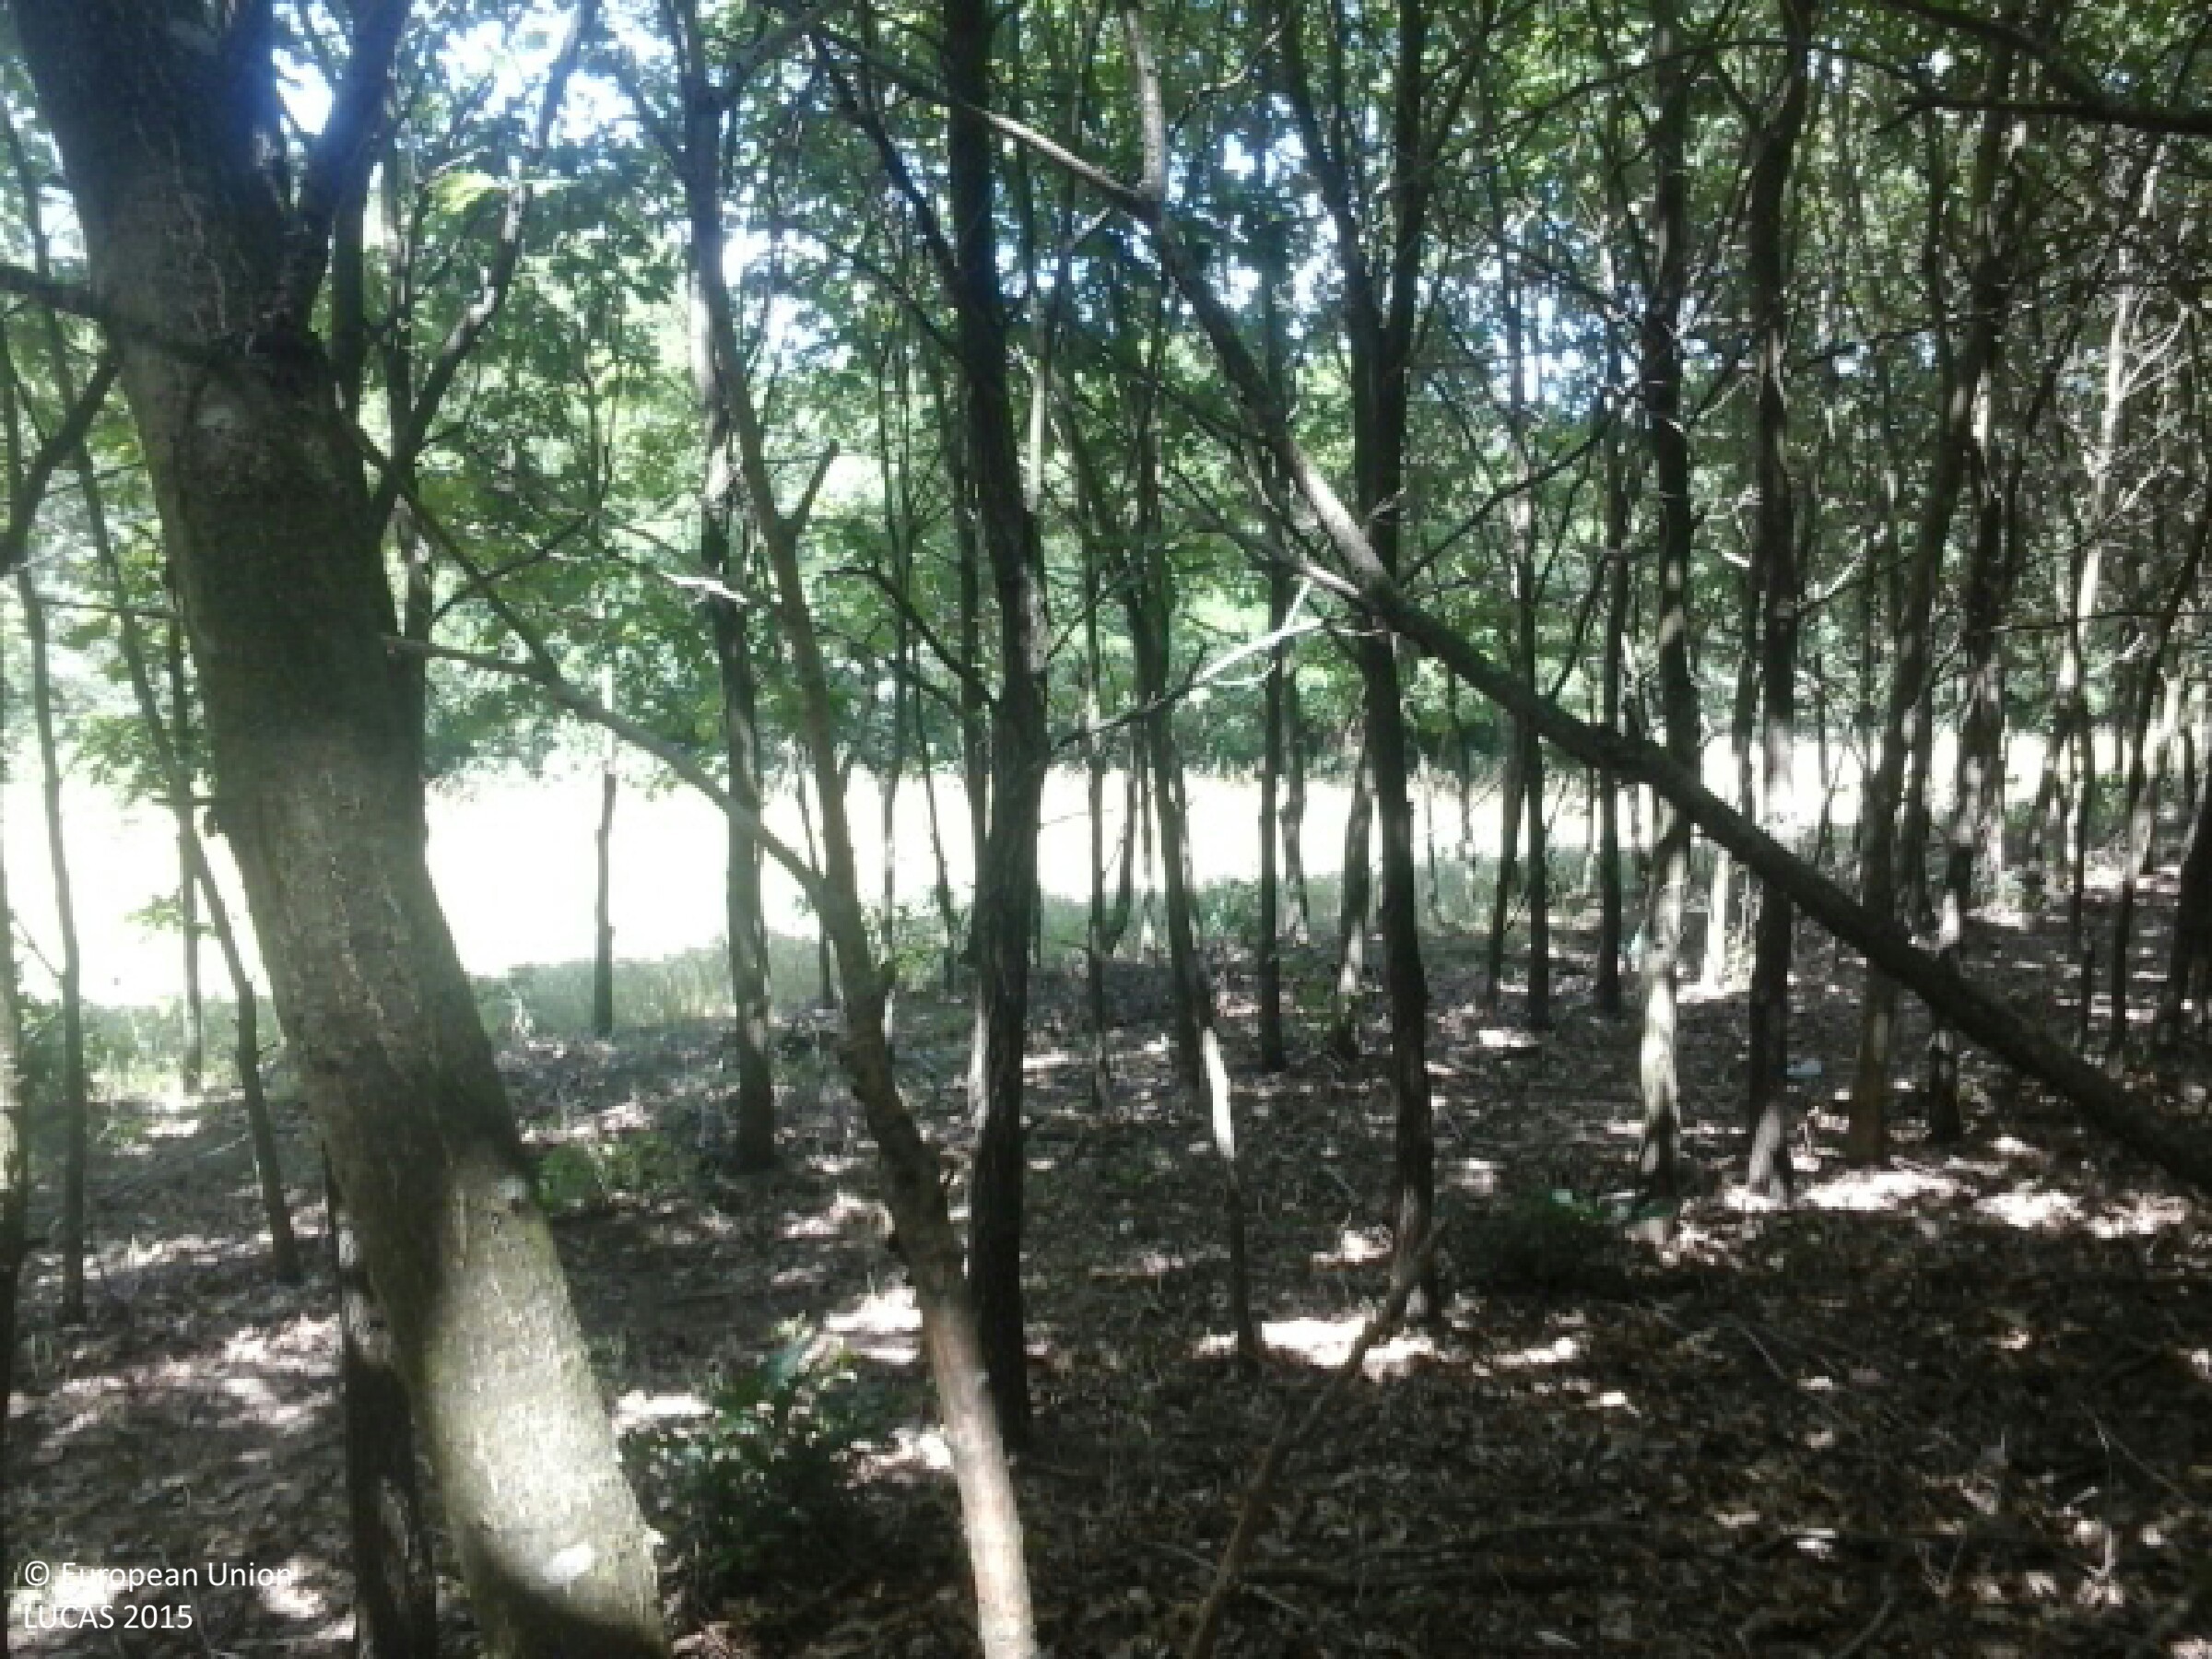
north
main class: Woodland
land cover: Broadleaved woodland
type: mesophytic deciduous forest
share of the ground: > 75 %
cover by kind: broadleaved forest trees 95 %, coniferous forest trees 5 %
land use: Forestry
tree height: > 5 m
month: July
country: HU
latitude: 48.4442
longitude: 21.6069
